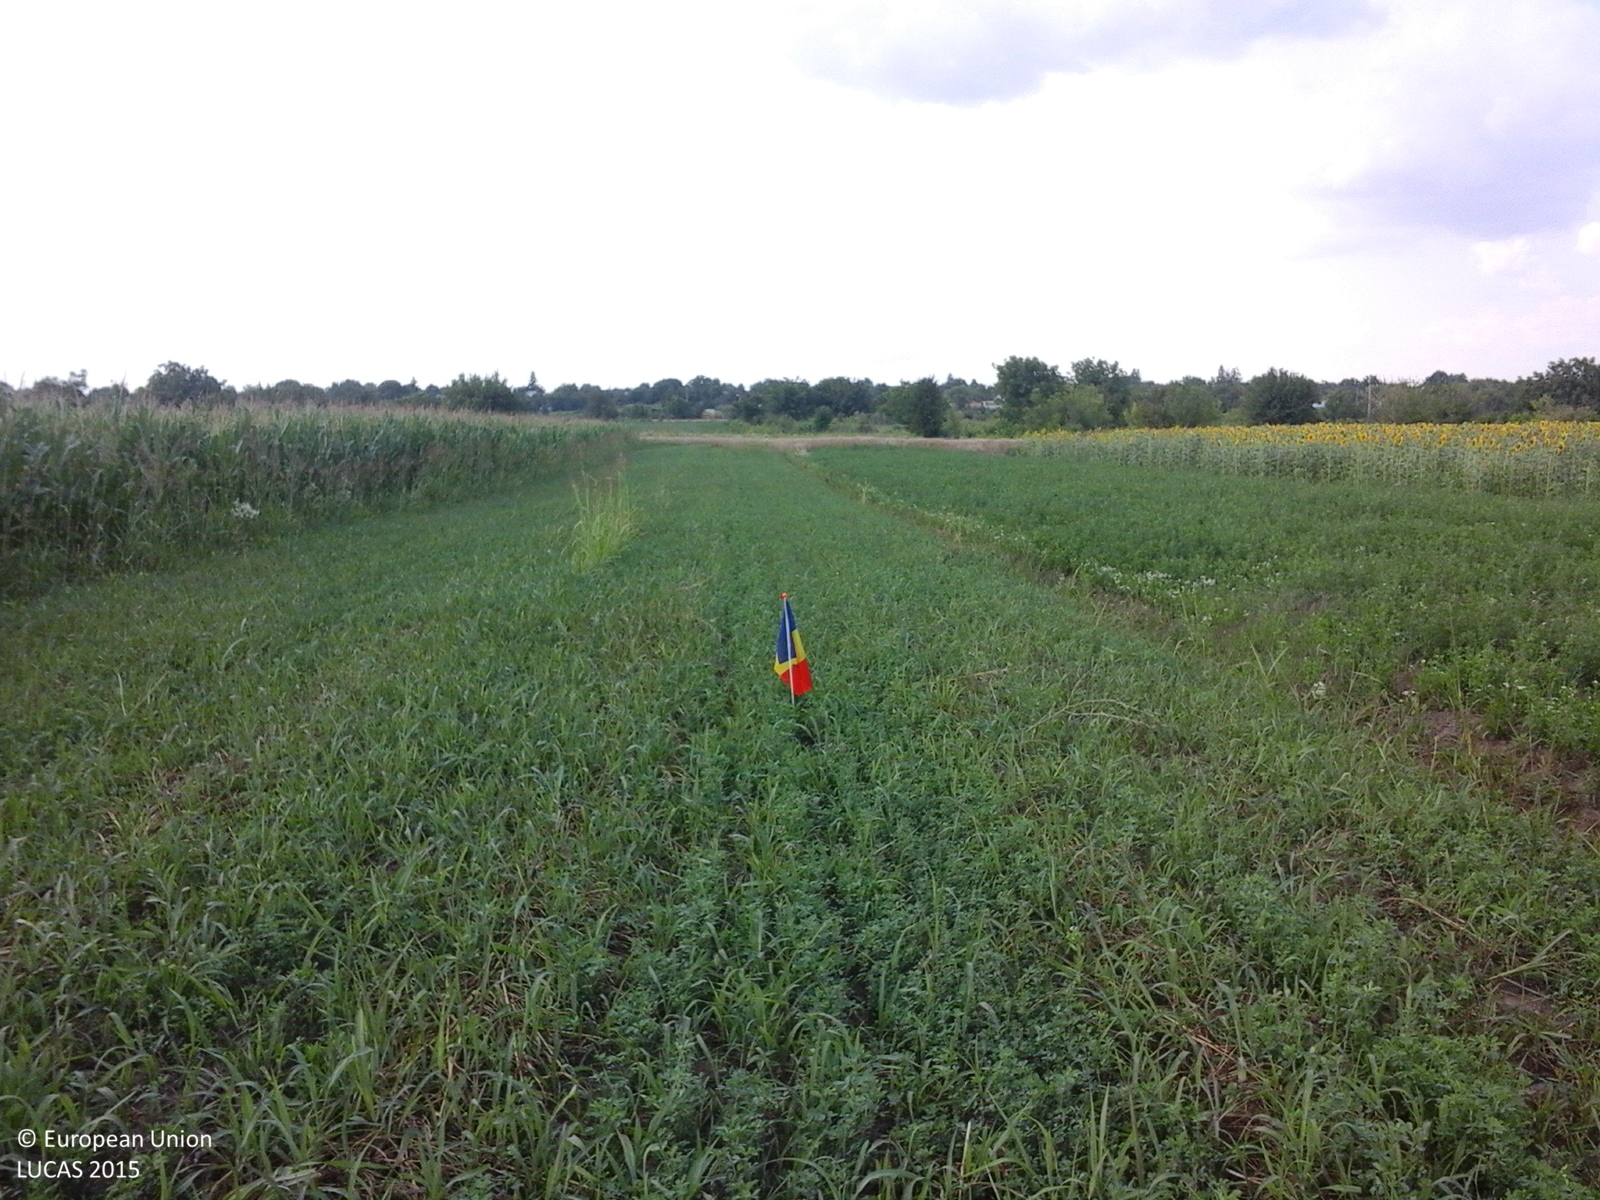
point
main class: Cropland
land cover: Lucerne
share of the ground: > 75 %
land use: Agriculture (excluding fallow land and kitchen gardens)
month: July
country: RO
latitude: 43.8487
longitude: 25.9047
